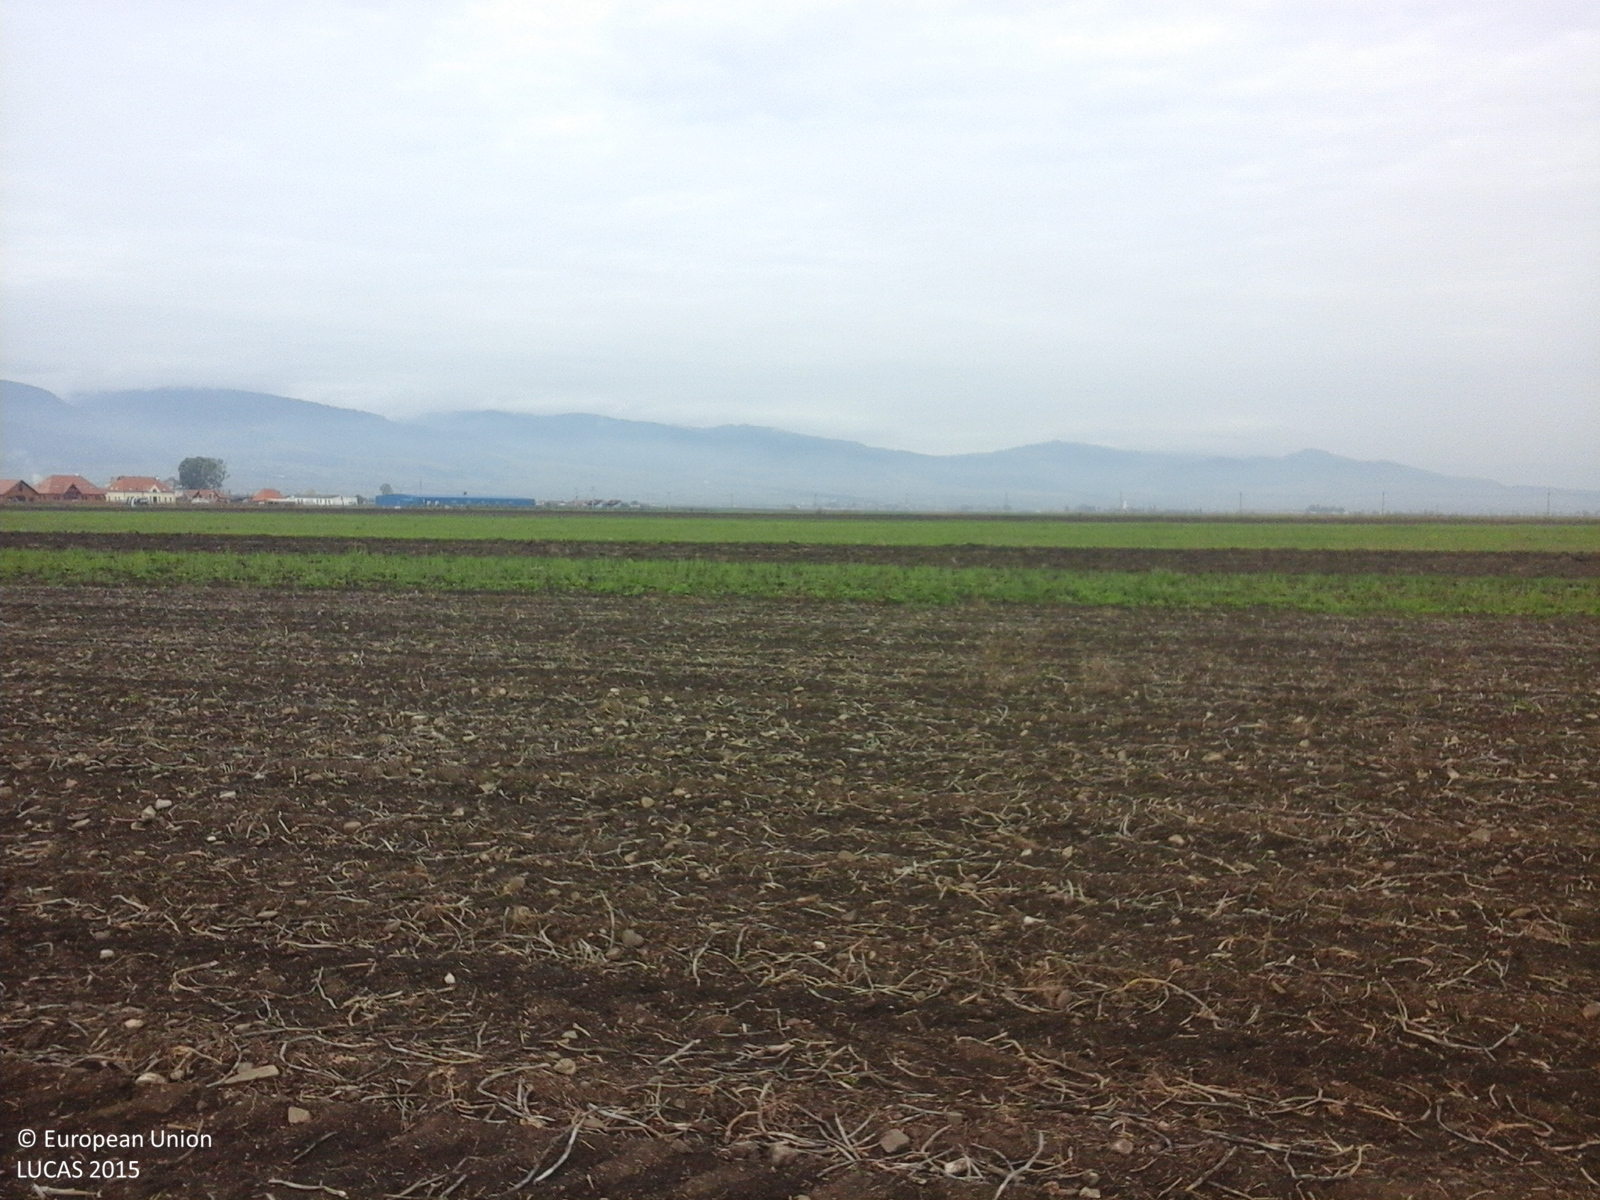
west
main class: Cropland
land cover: Potatoes
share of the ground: < 10 %
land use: Agriculture (excluding fallow land and kitchen gardens)
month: October
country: RO
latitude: 46.2699
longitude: 25.9083
